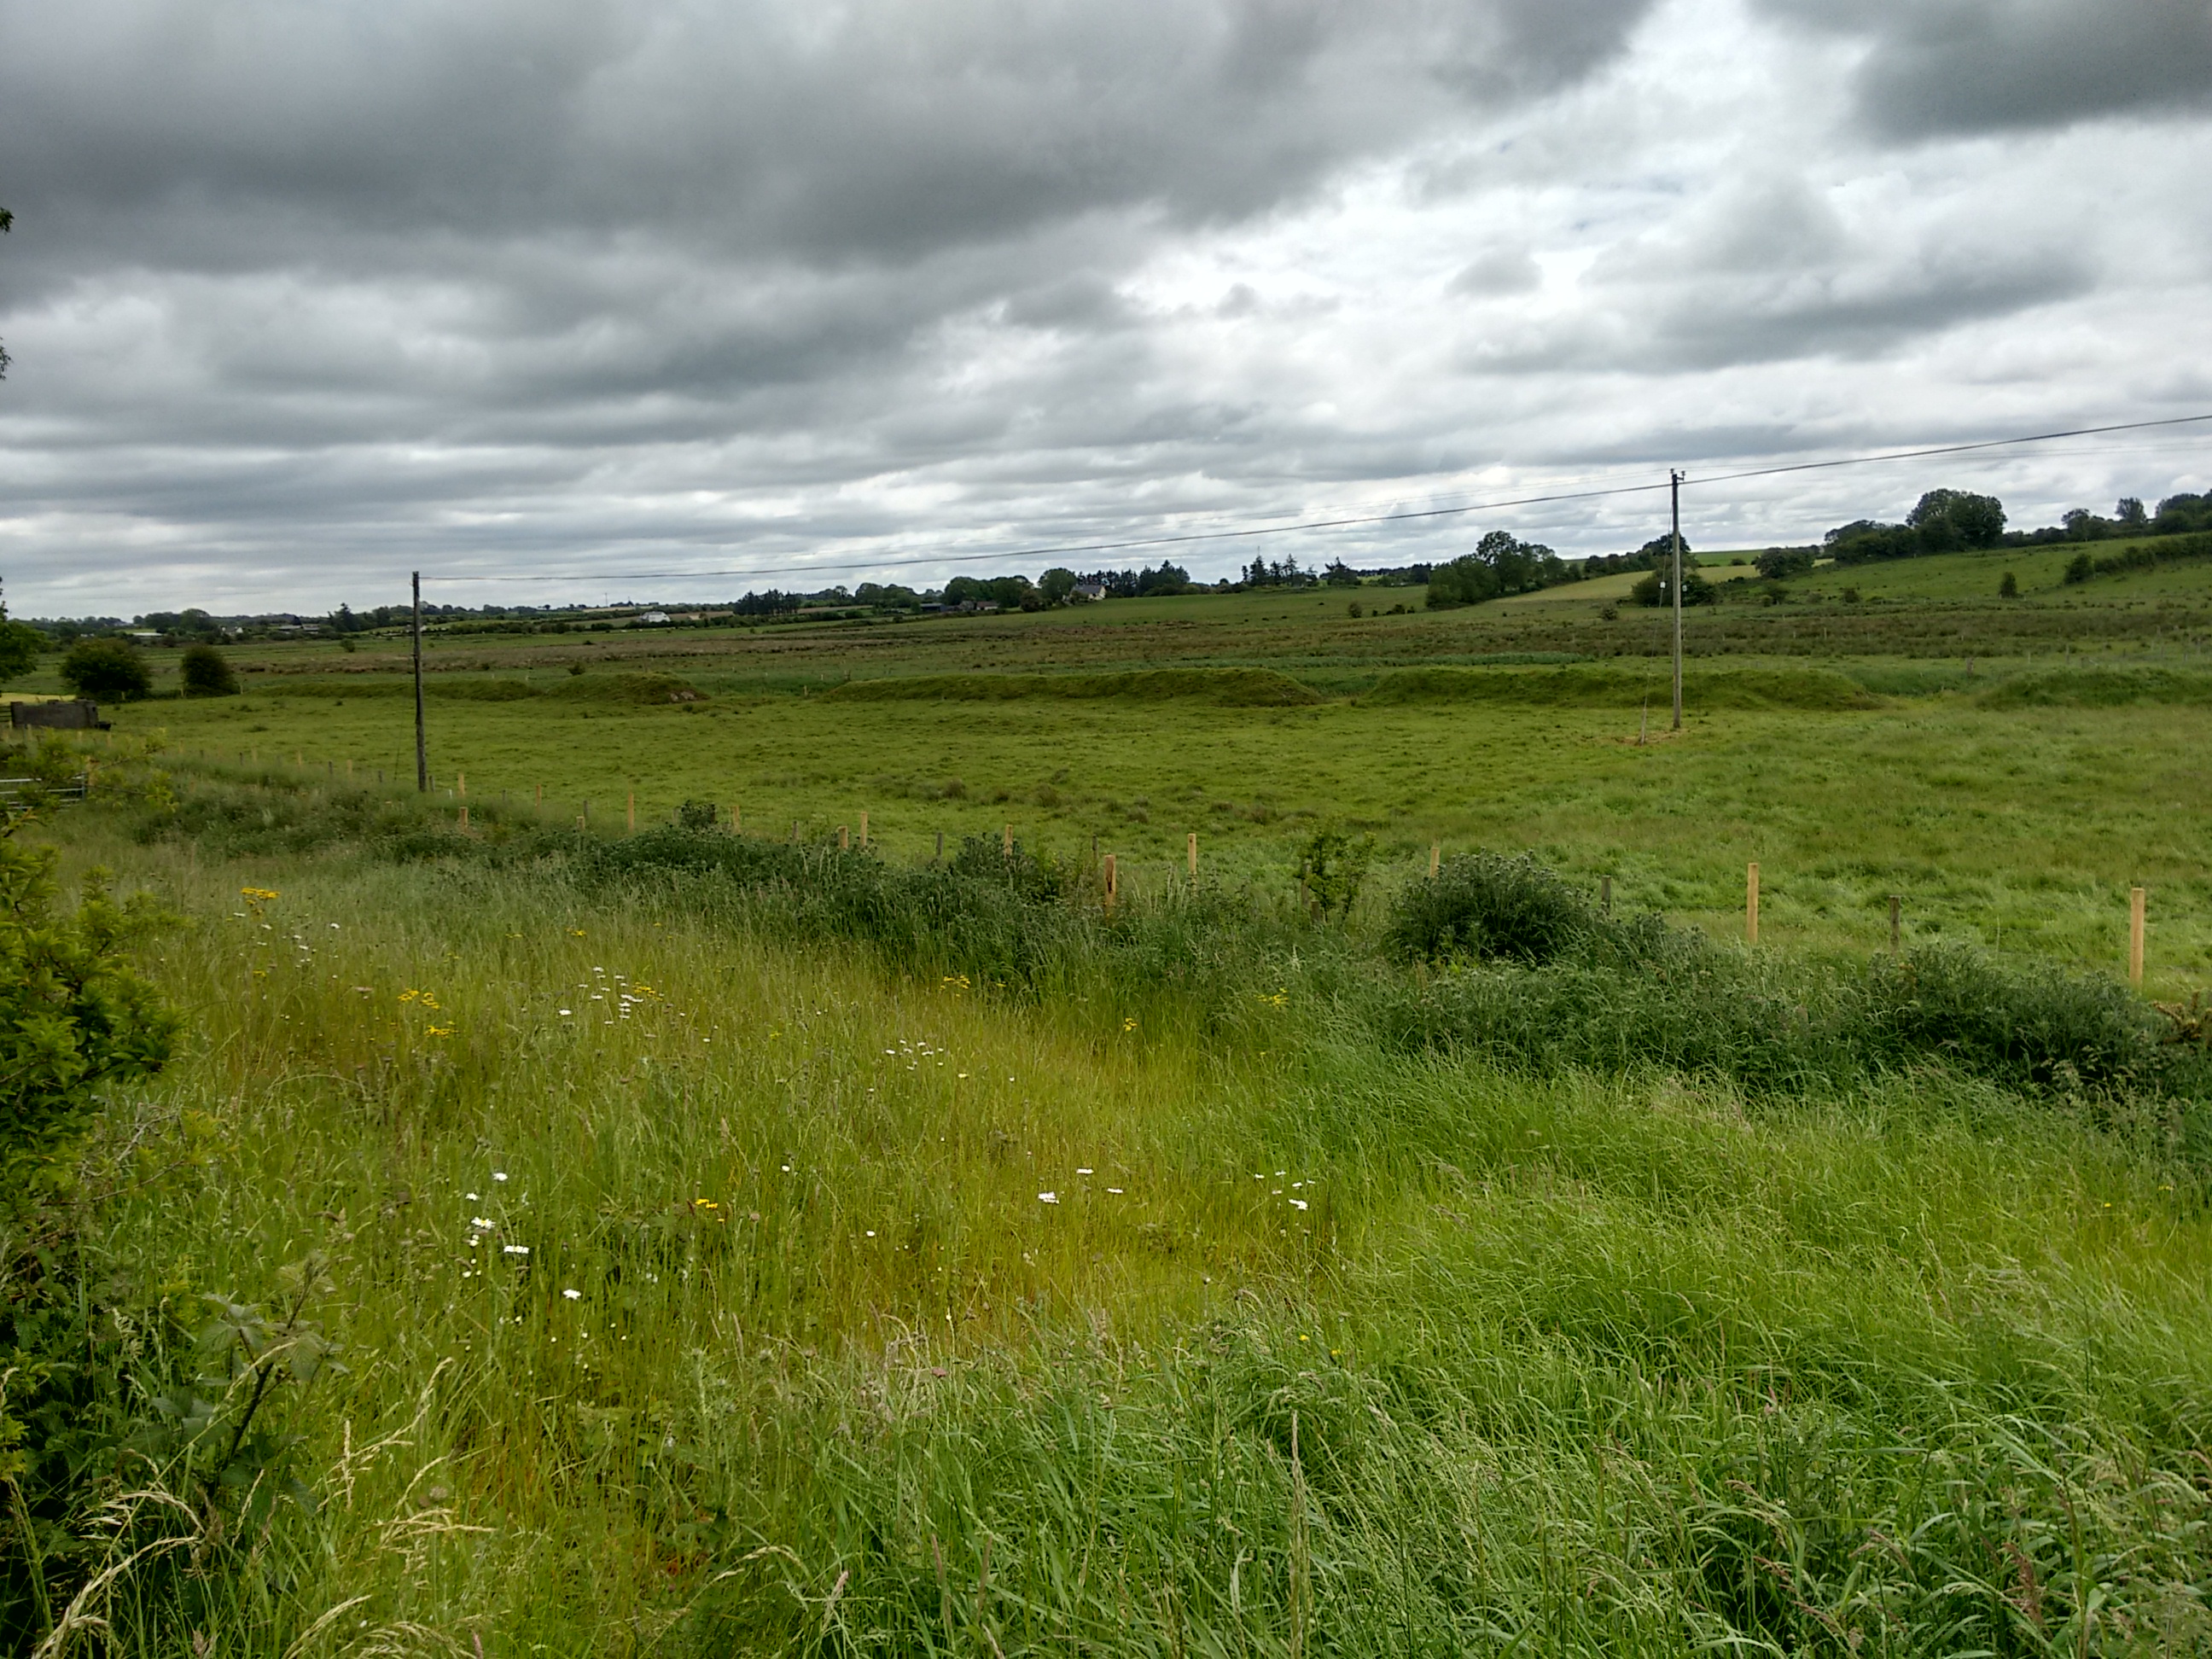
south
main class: Grassland
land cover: Grassland without tree/shrub cover
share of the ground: > 75 %
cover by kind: herbaceous plants 100 %
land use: Agriculture (excluding fallow land and kitchen gardens)
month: June
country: IE
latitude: 53.6049
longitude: -8.8401
